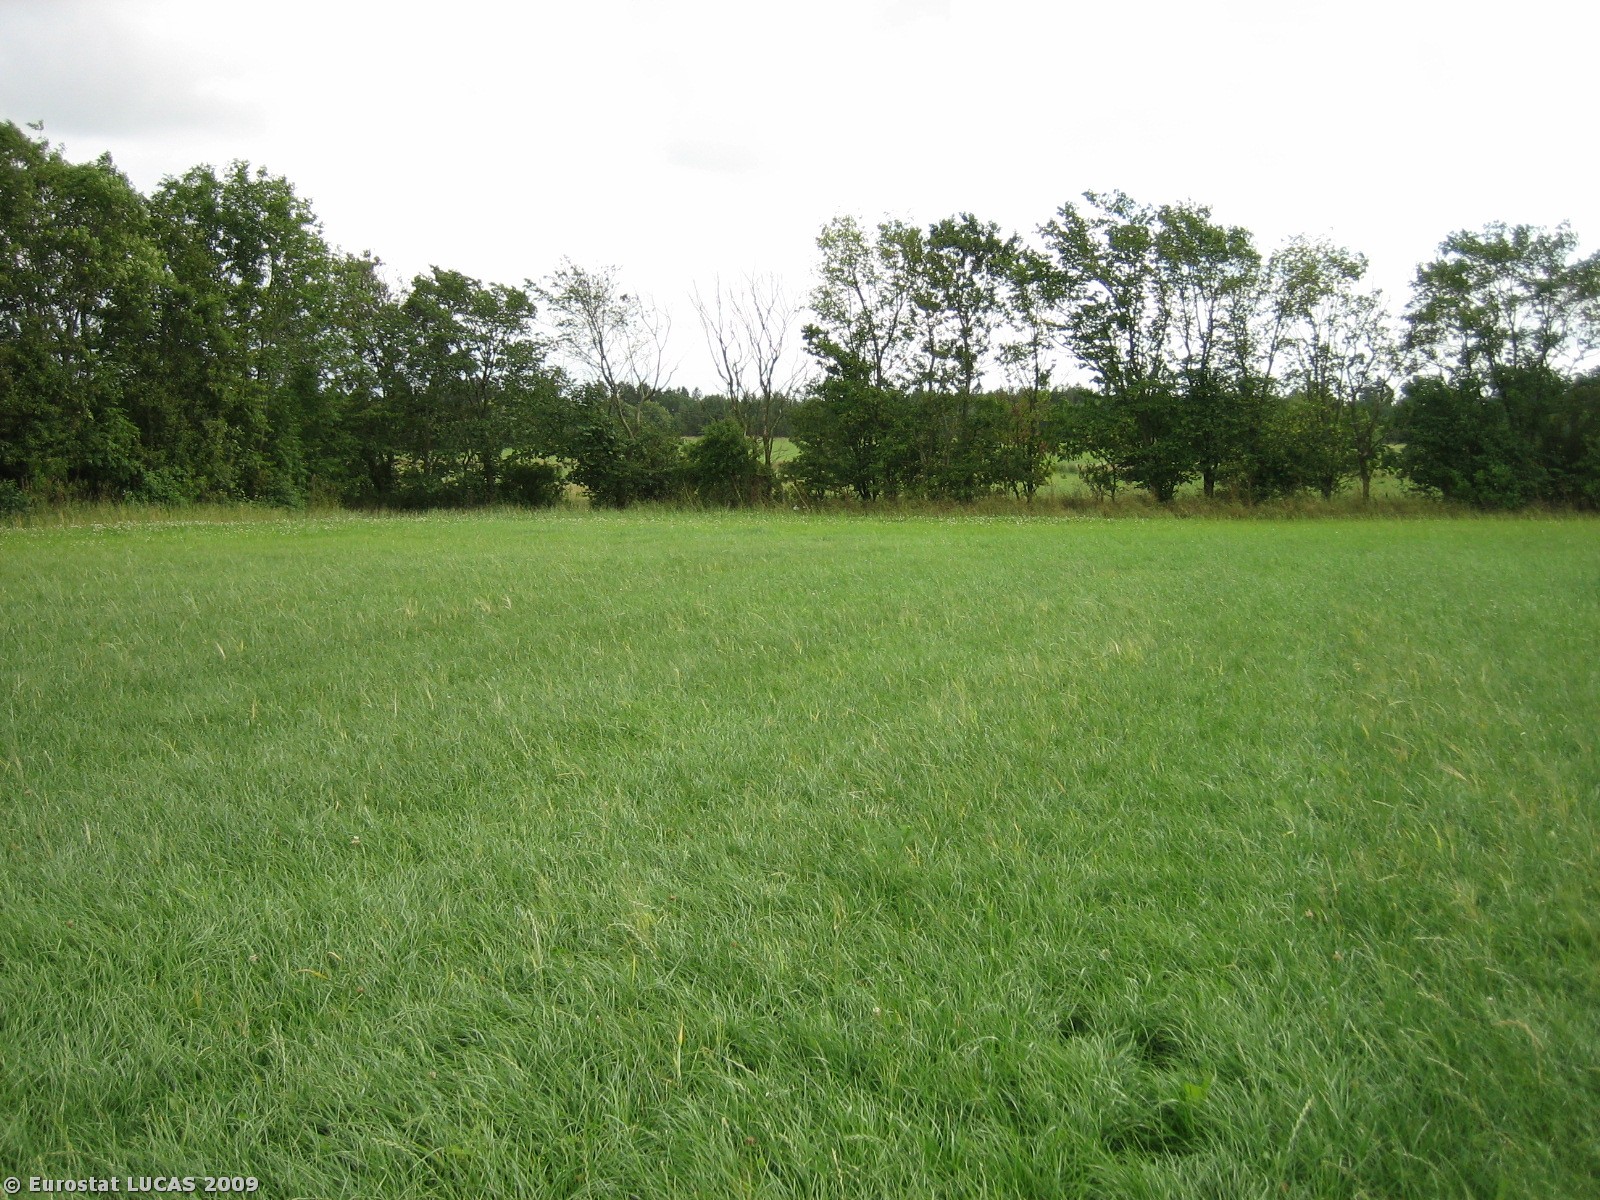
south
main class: Cropland
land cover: Temporary grasslands
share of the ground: > 75 %
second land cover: Rye
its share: < 10 %
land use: Agriculture (excluding fallow land and kitchen gardens)
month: July
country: DK
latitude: 55.6962
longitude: 8.7443
